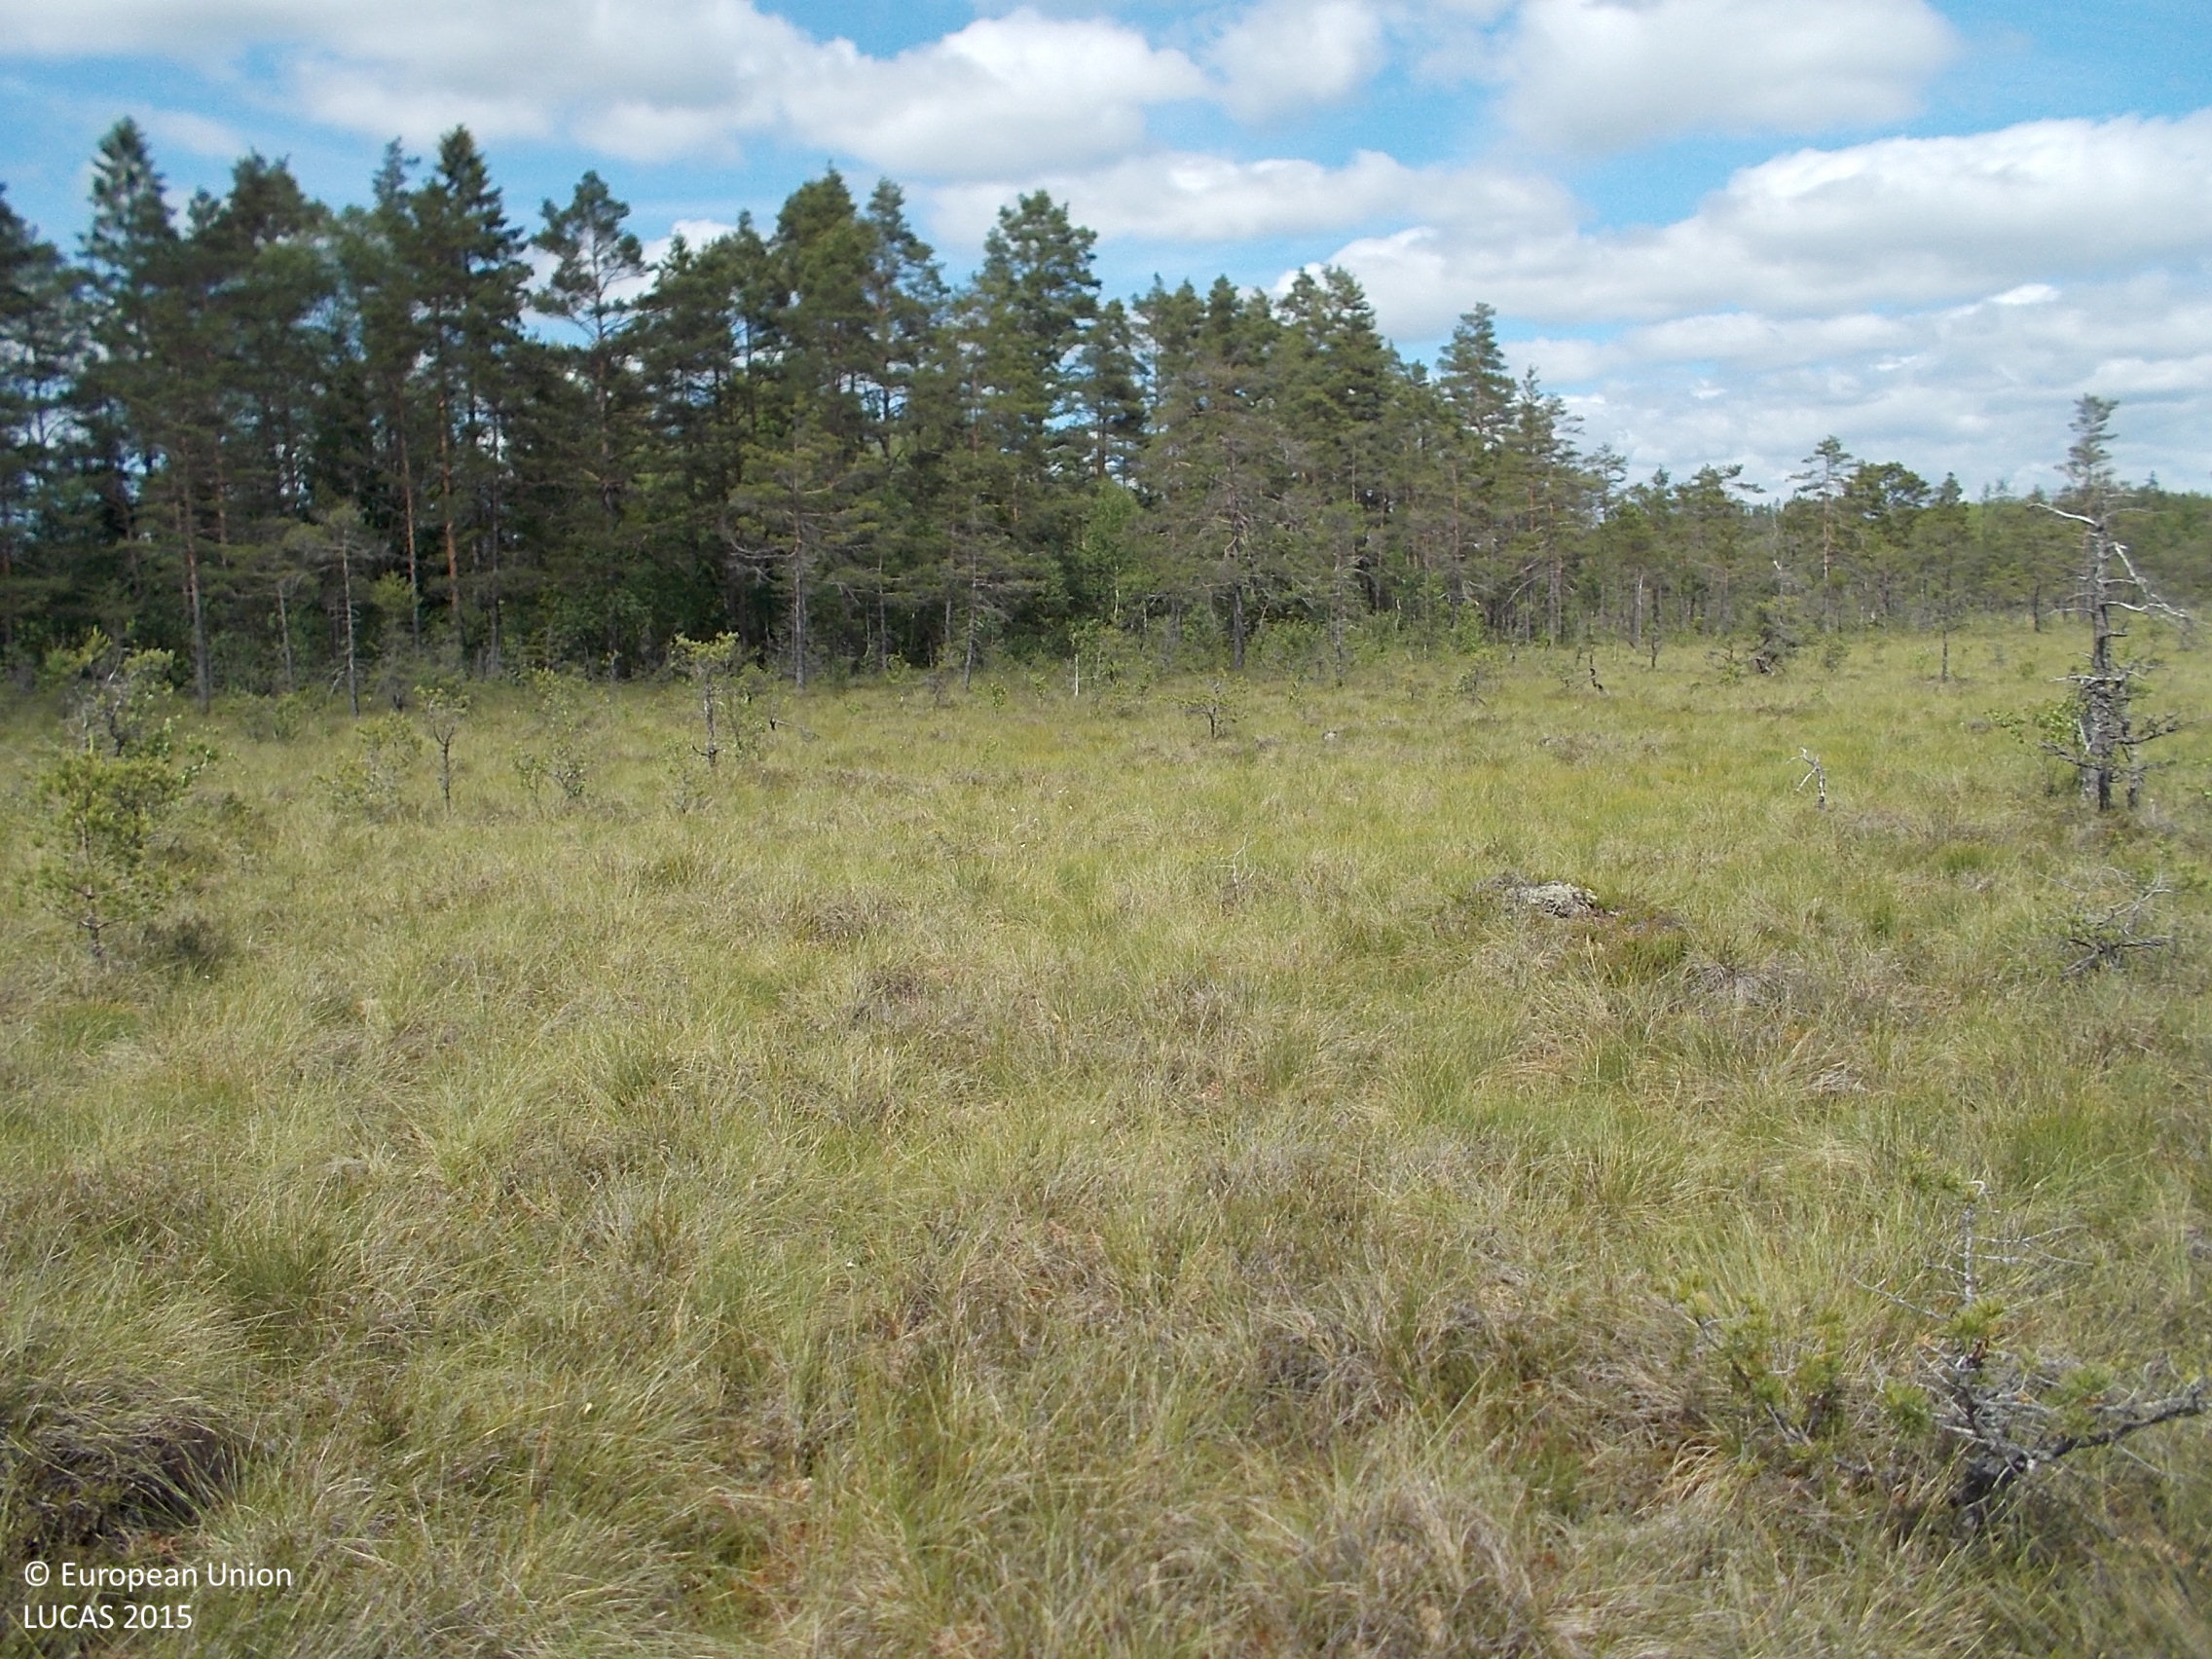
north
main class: Shrubland
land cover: Shrubland with sparse tree cover
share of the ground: 50 - 75 %
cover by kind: shrubs 50 %, herbaceous plants 45 %, coniferous forest trees 5 %
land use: Semi-natural and natural areas not in use
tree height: < 5 m
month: June
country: SE
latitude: 57.2855
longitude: 13.0320
